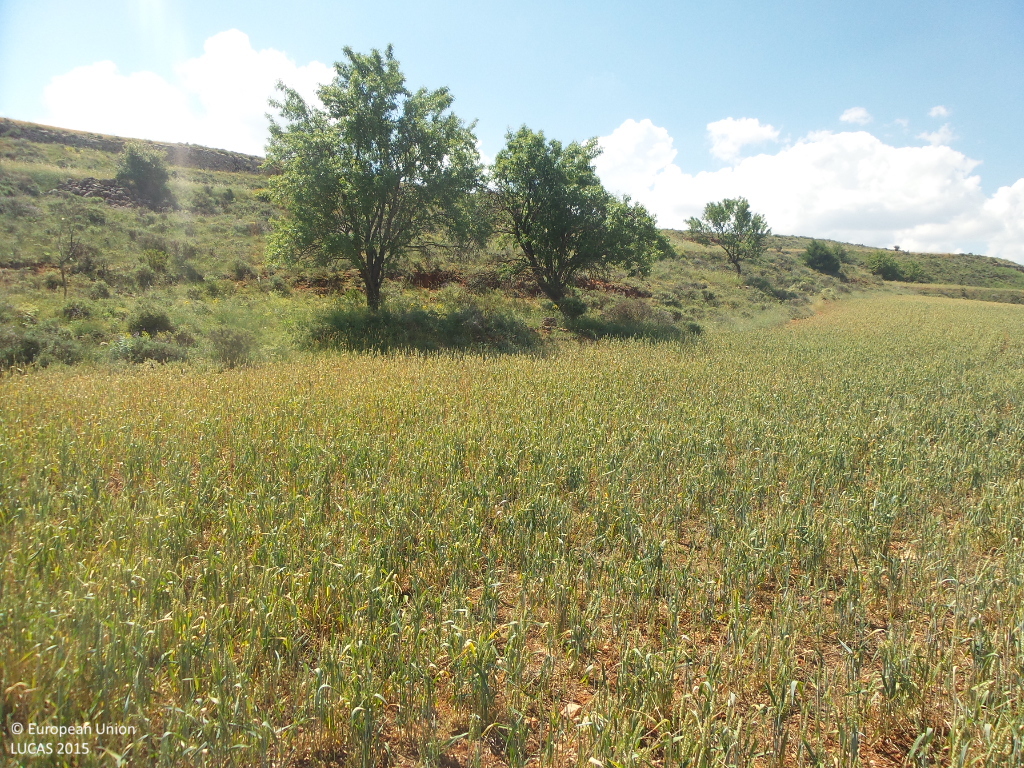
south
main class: Cropland
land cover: Common wheat
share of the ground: > 75 %
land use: Agriculture (excluding fallow land and kitchen gardens)
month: June
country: ES
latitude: 41.4014
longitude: -3.0671
